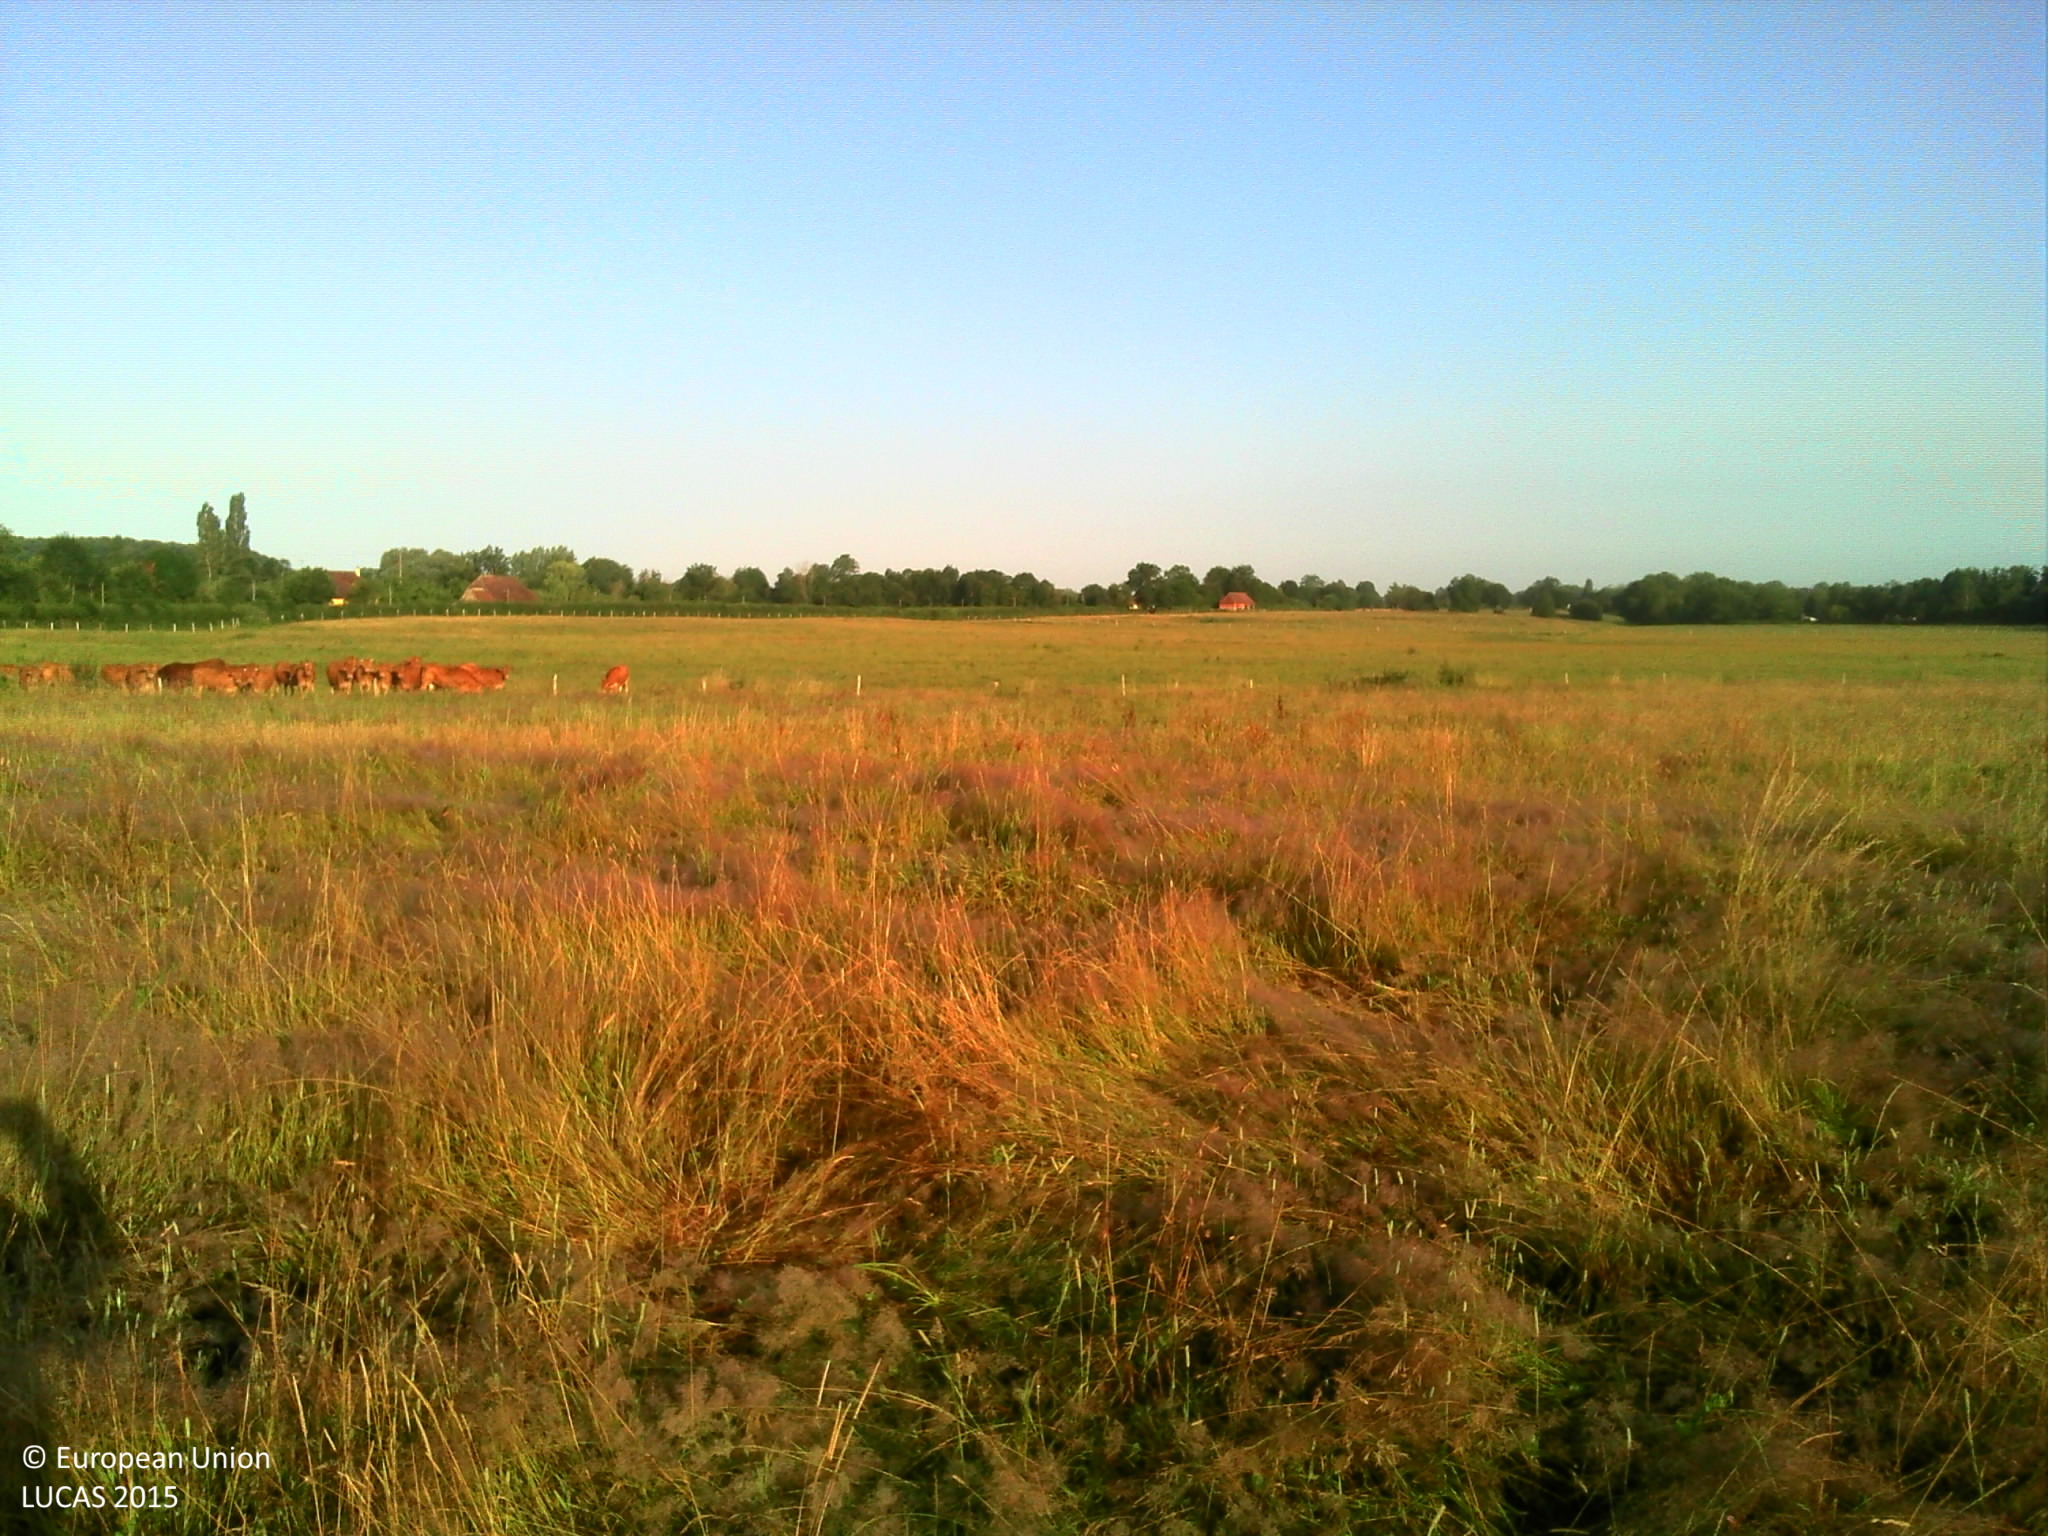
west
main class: Grassland
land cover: Grassland without tree/shrub cover
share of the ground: > 75 %
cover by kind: herbaceous plants 100 %
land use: Agriculture (excluding fallow land and kitchen gardens)
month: July
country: FR
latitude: 49.0793
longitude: 0.0715
